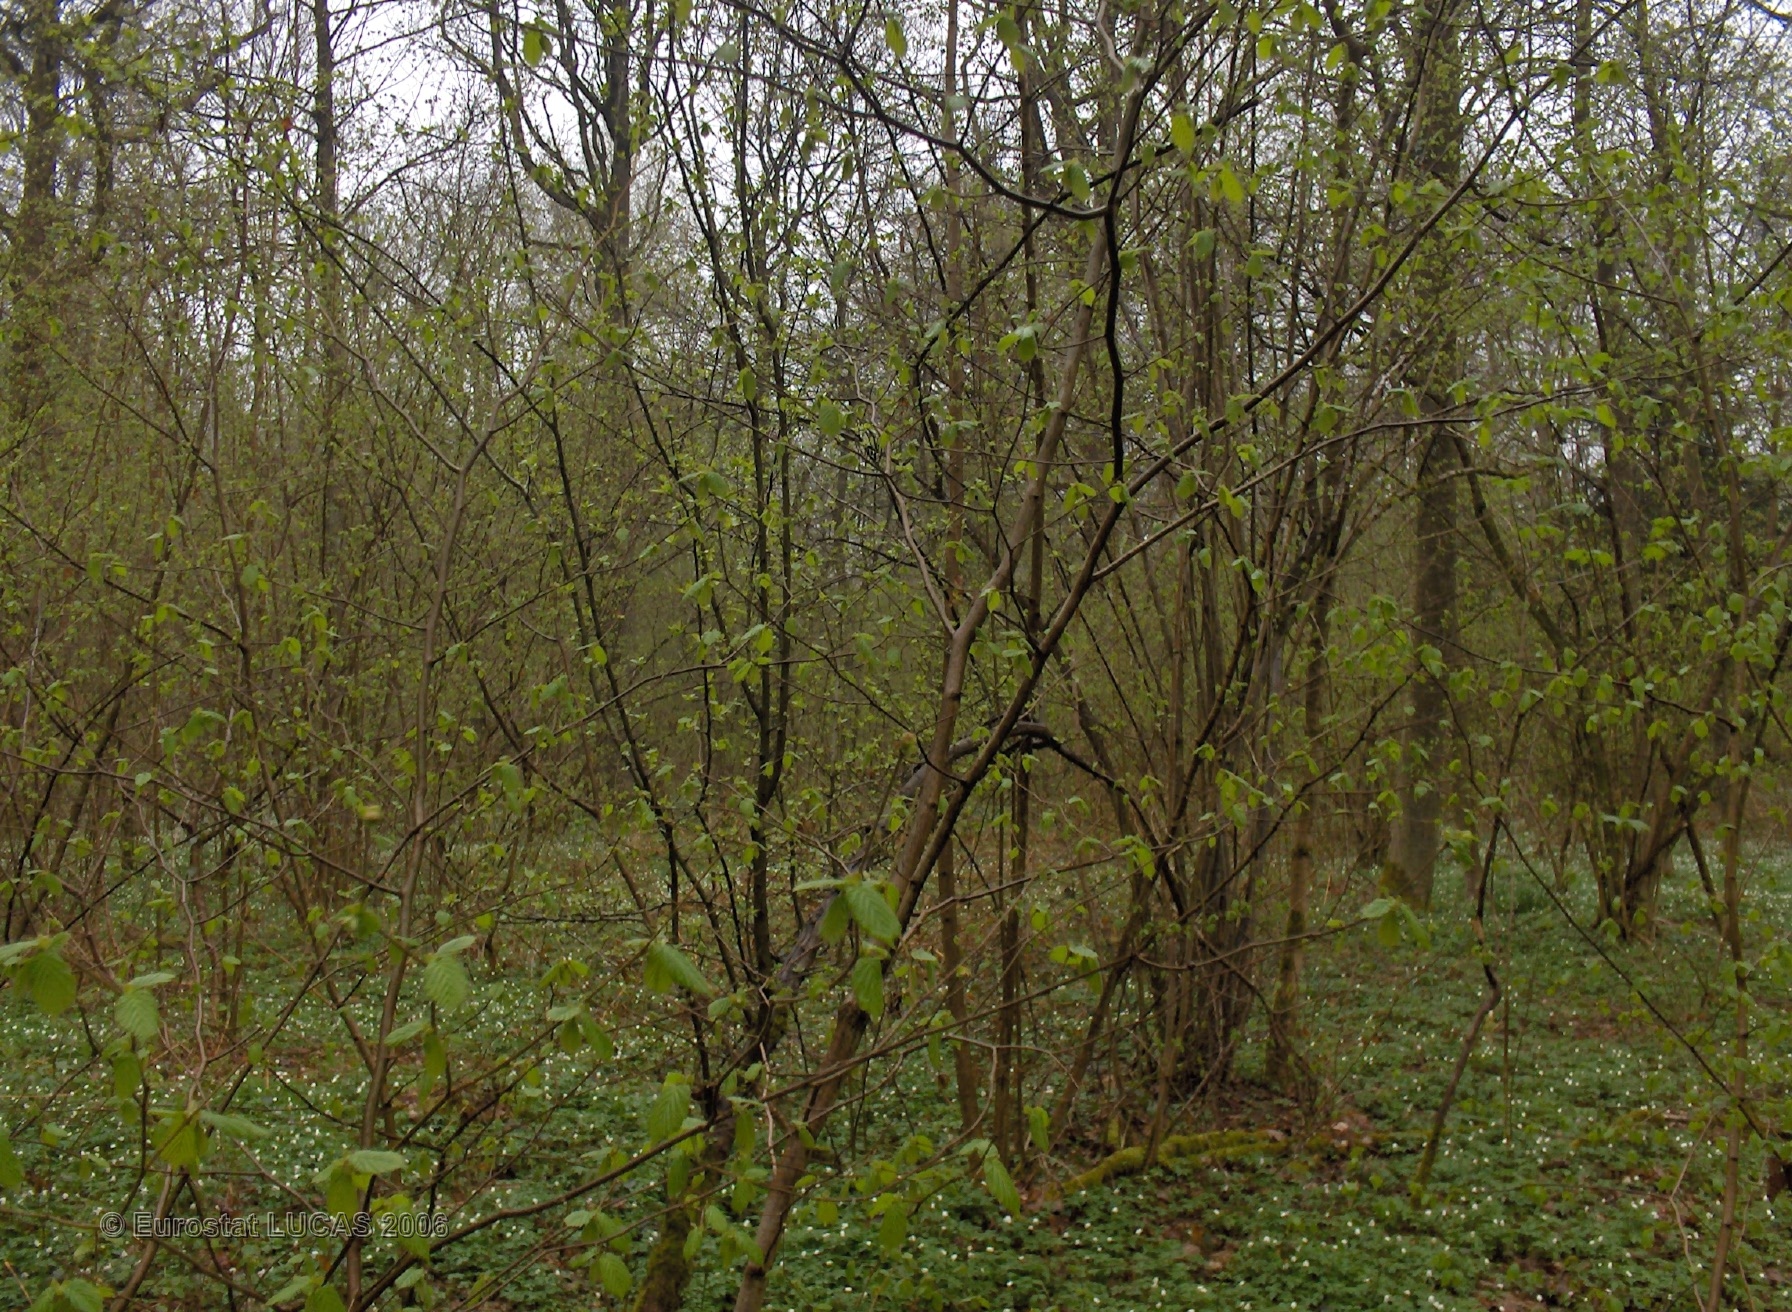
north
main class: Woodland
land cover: Broadleaved forest
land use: Forestry
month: April
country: BE
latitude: 50.2903
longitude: 4.5923
